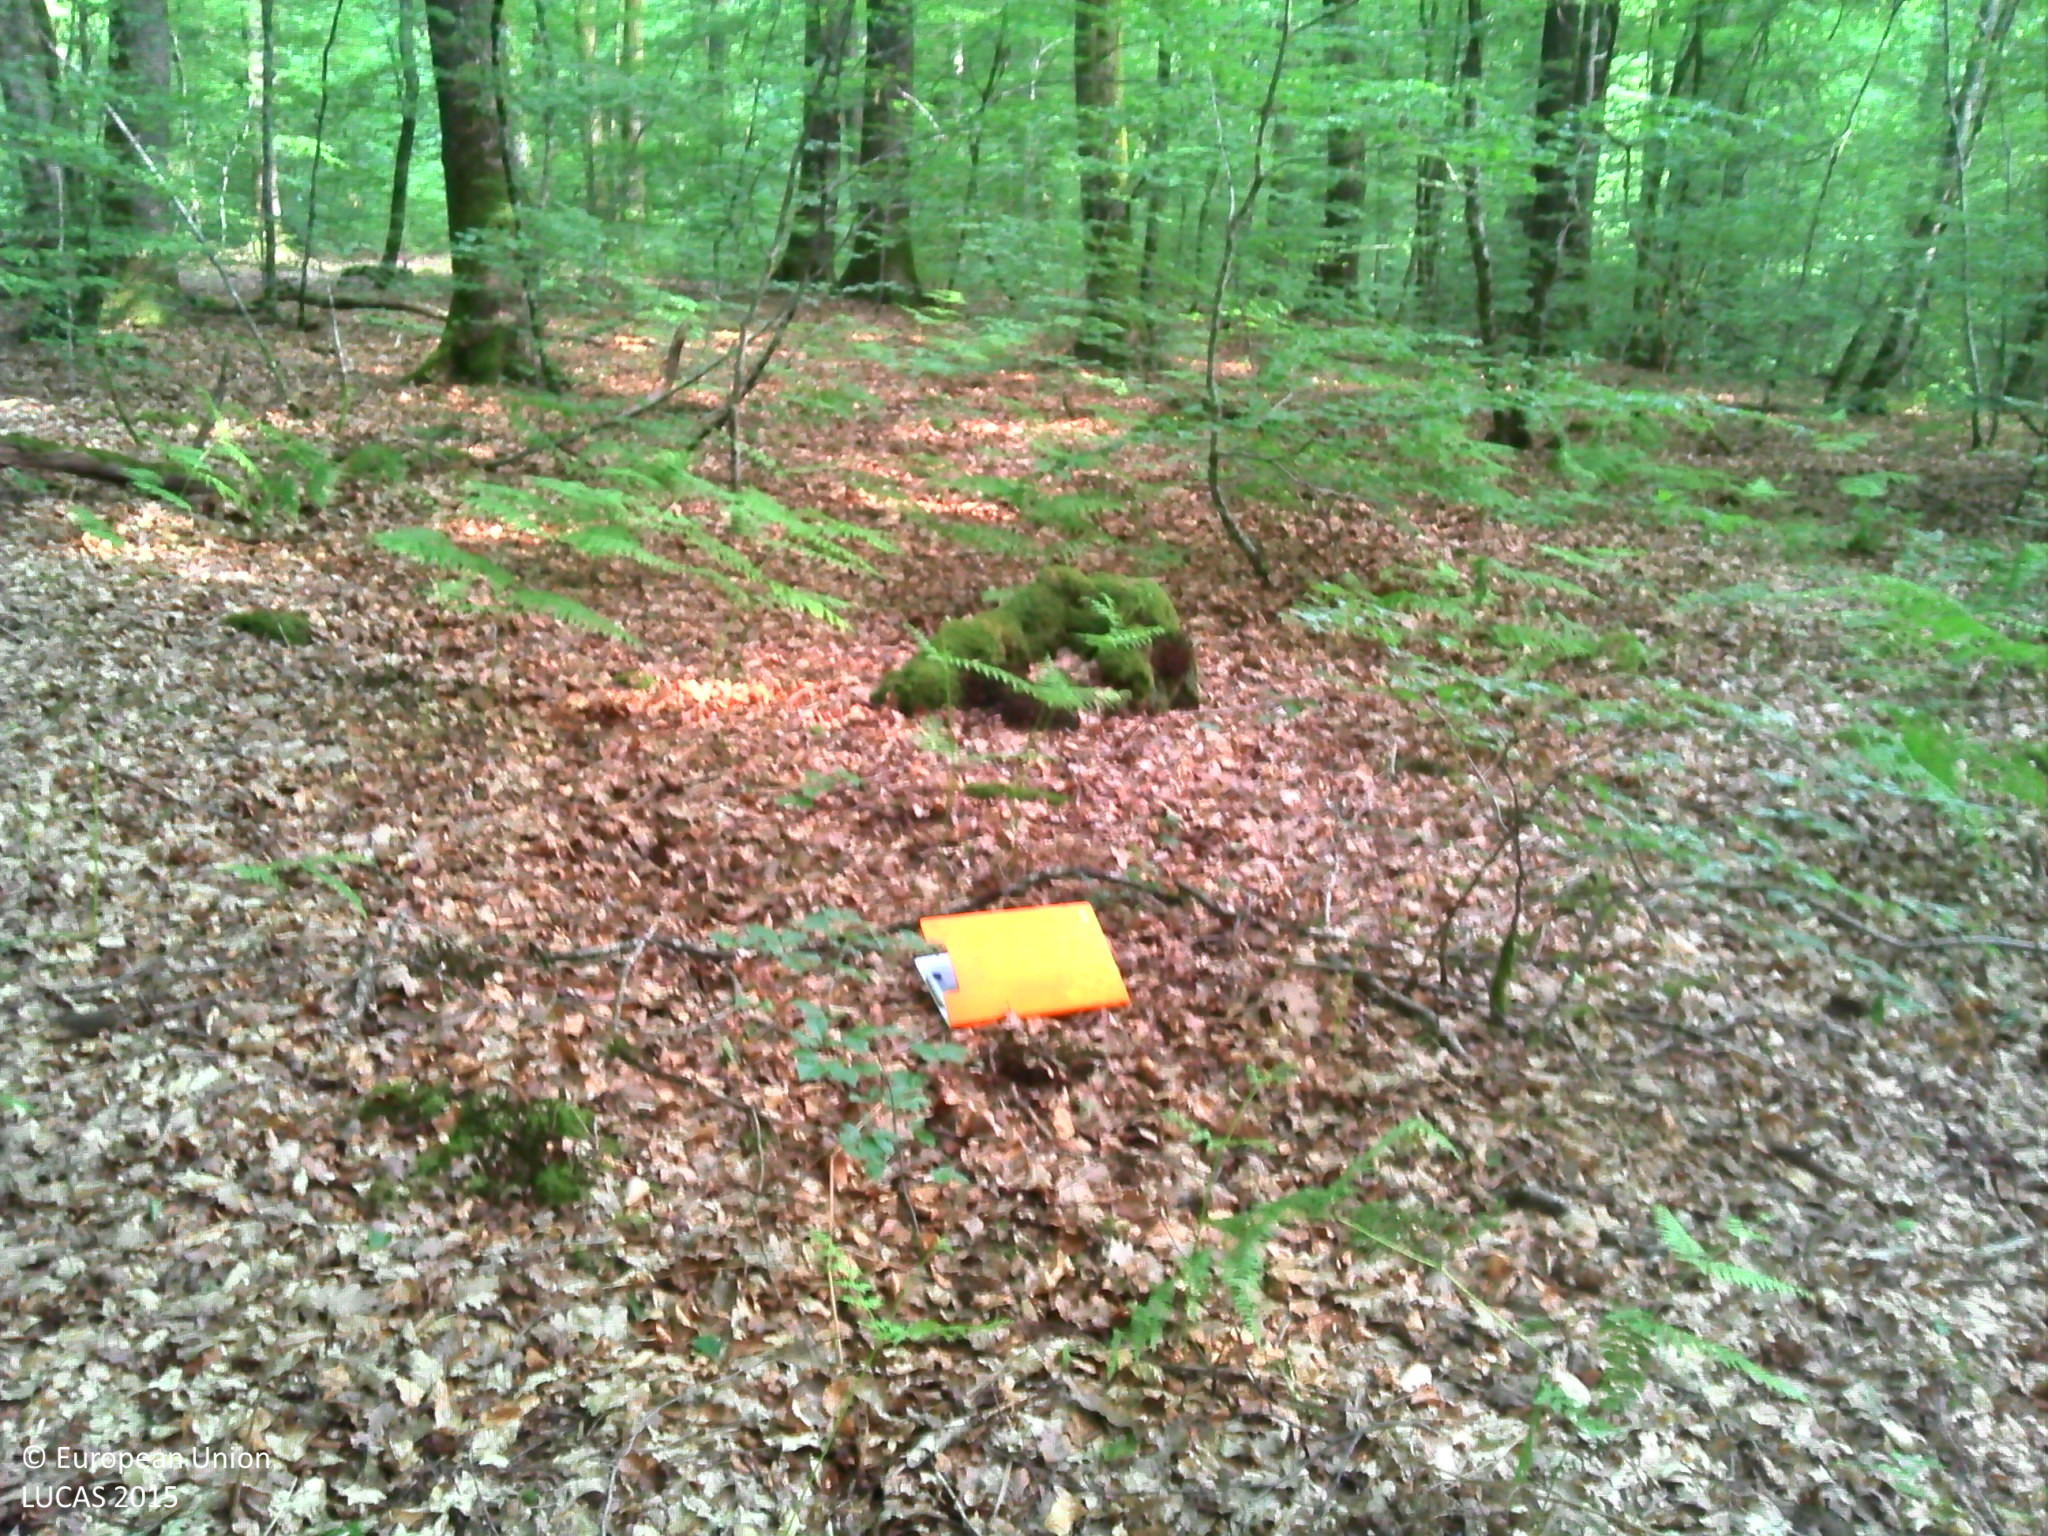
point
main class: Woodland
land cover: Broadleaved woodland
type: beech forest
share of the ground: > 75 %
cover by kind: broadleaved forest trees 95 %, herbaceous plants 5 %
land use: Forestry
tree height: > 5 m
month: June
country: FR
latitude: 47.8308
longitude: 6.1134
